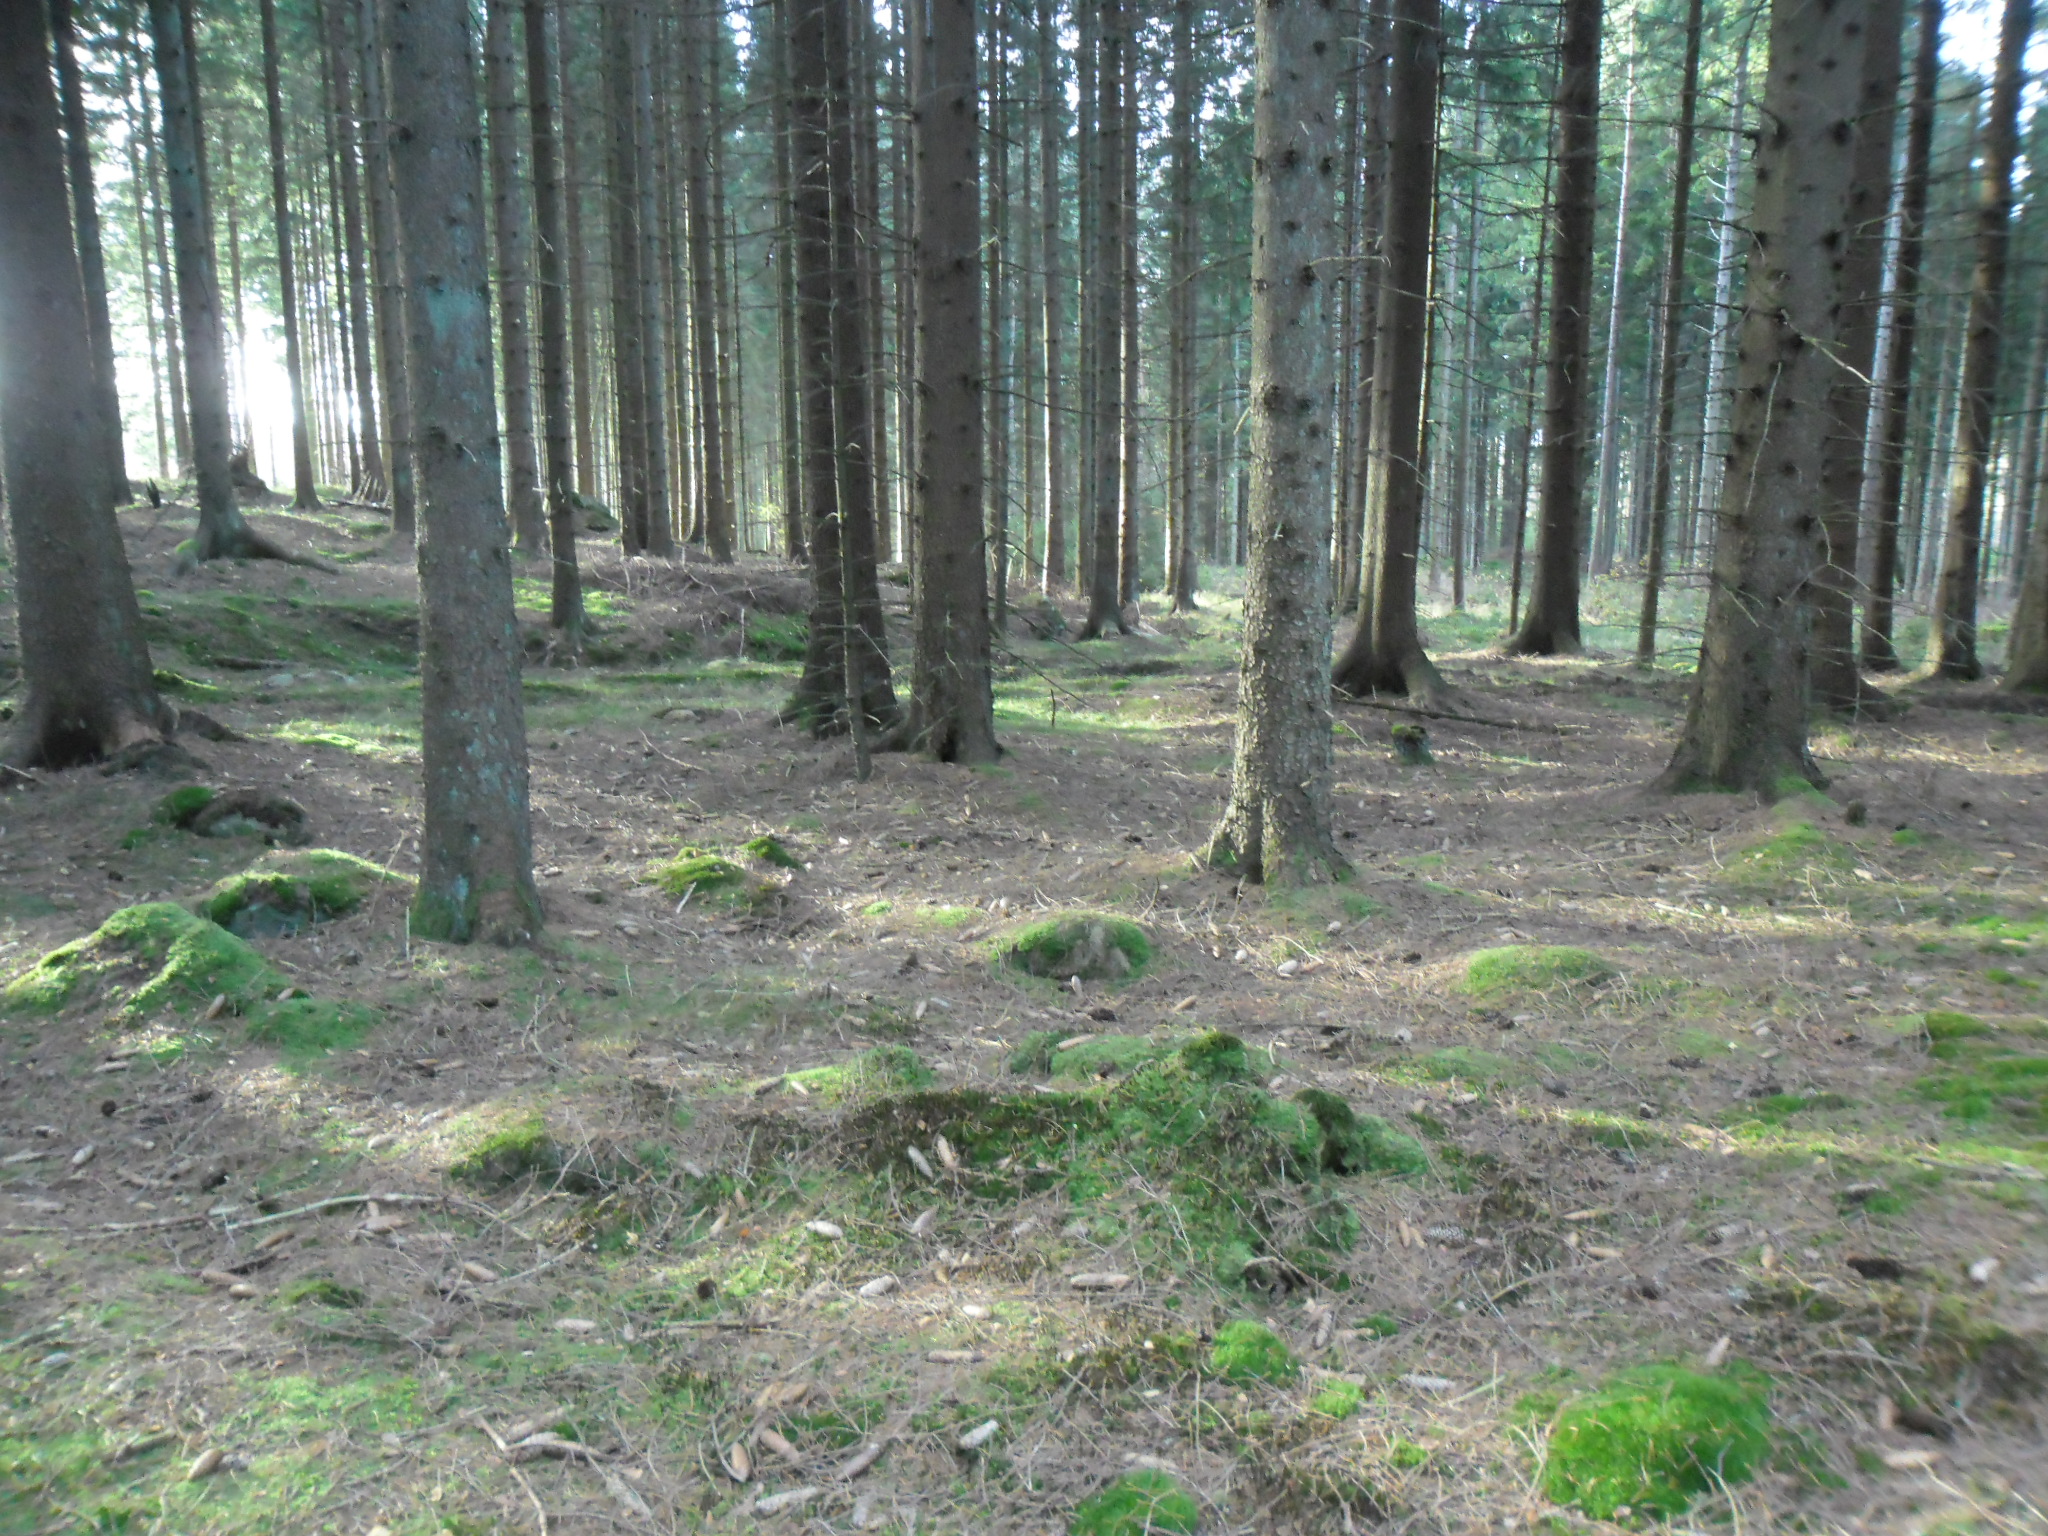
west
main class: Woodland
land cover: Spruce dominated coniferous woodland
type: boreal forest
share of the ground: > 75 %
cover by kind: coniferous forest trees 80 %, lichens and mosses 20 %
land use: Forestry
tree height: > 5 m
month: October
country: SE
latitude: 56.4001
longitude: 13.1891
